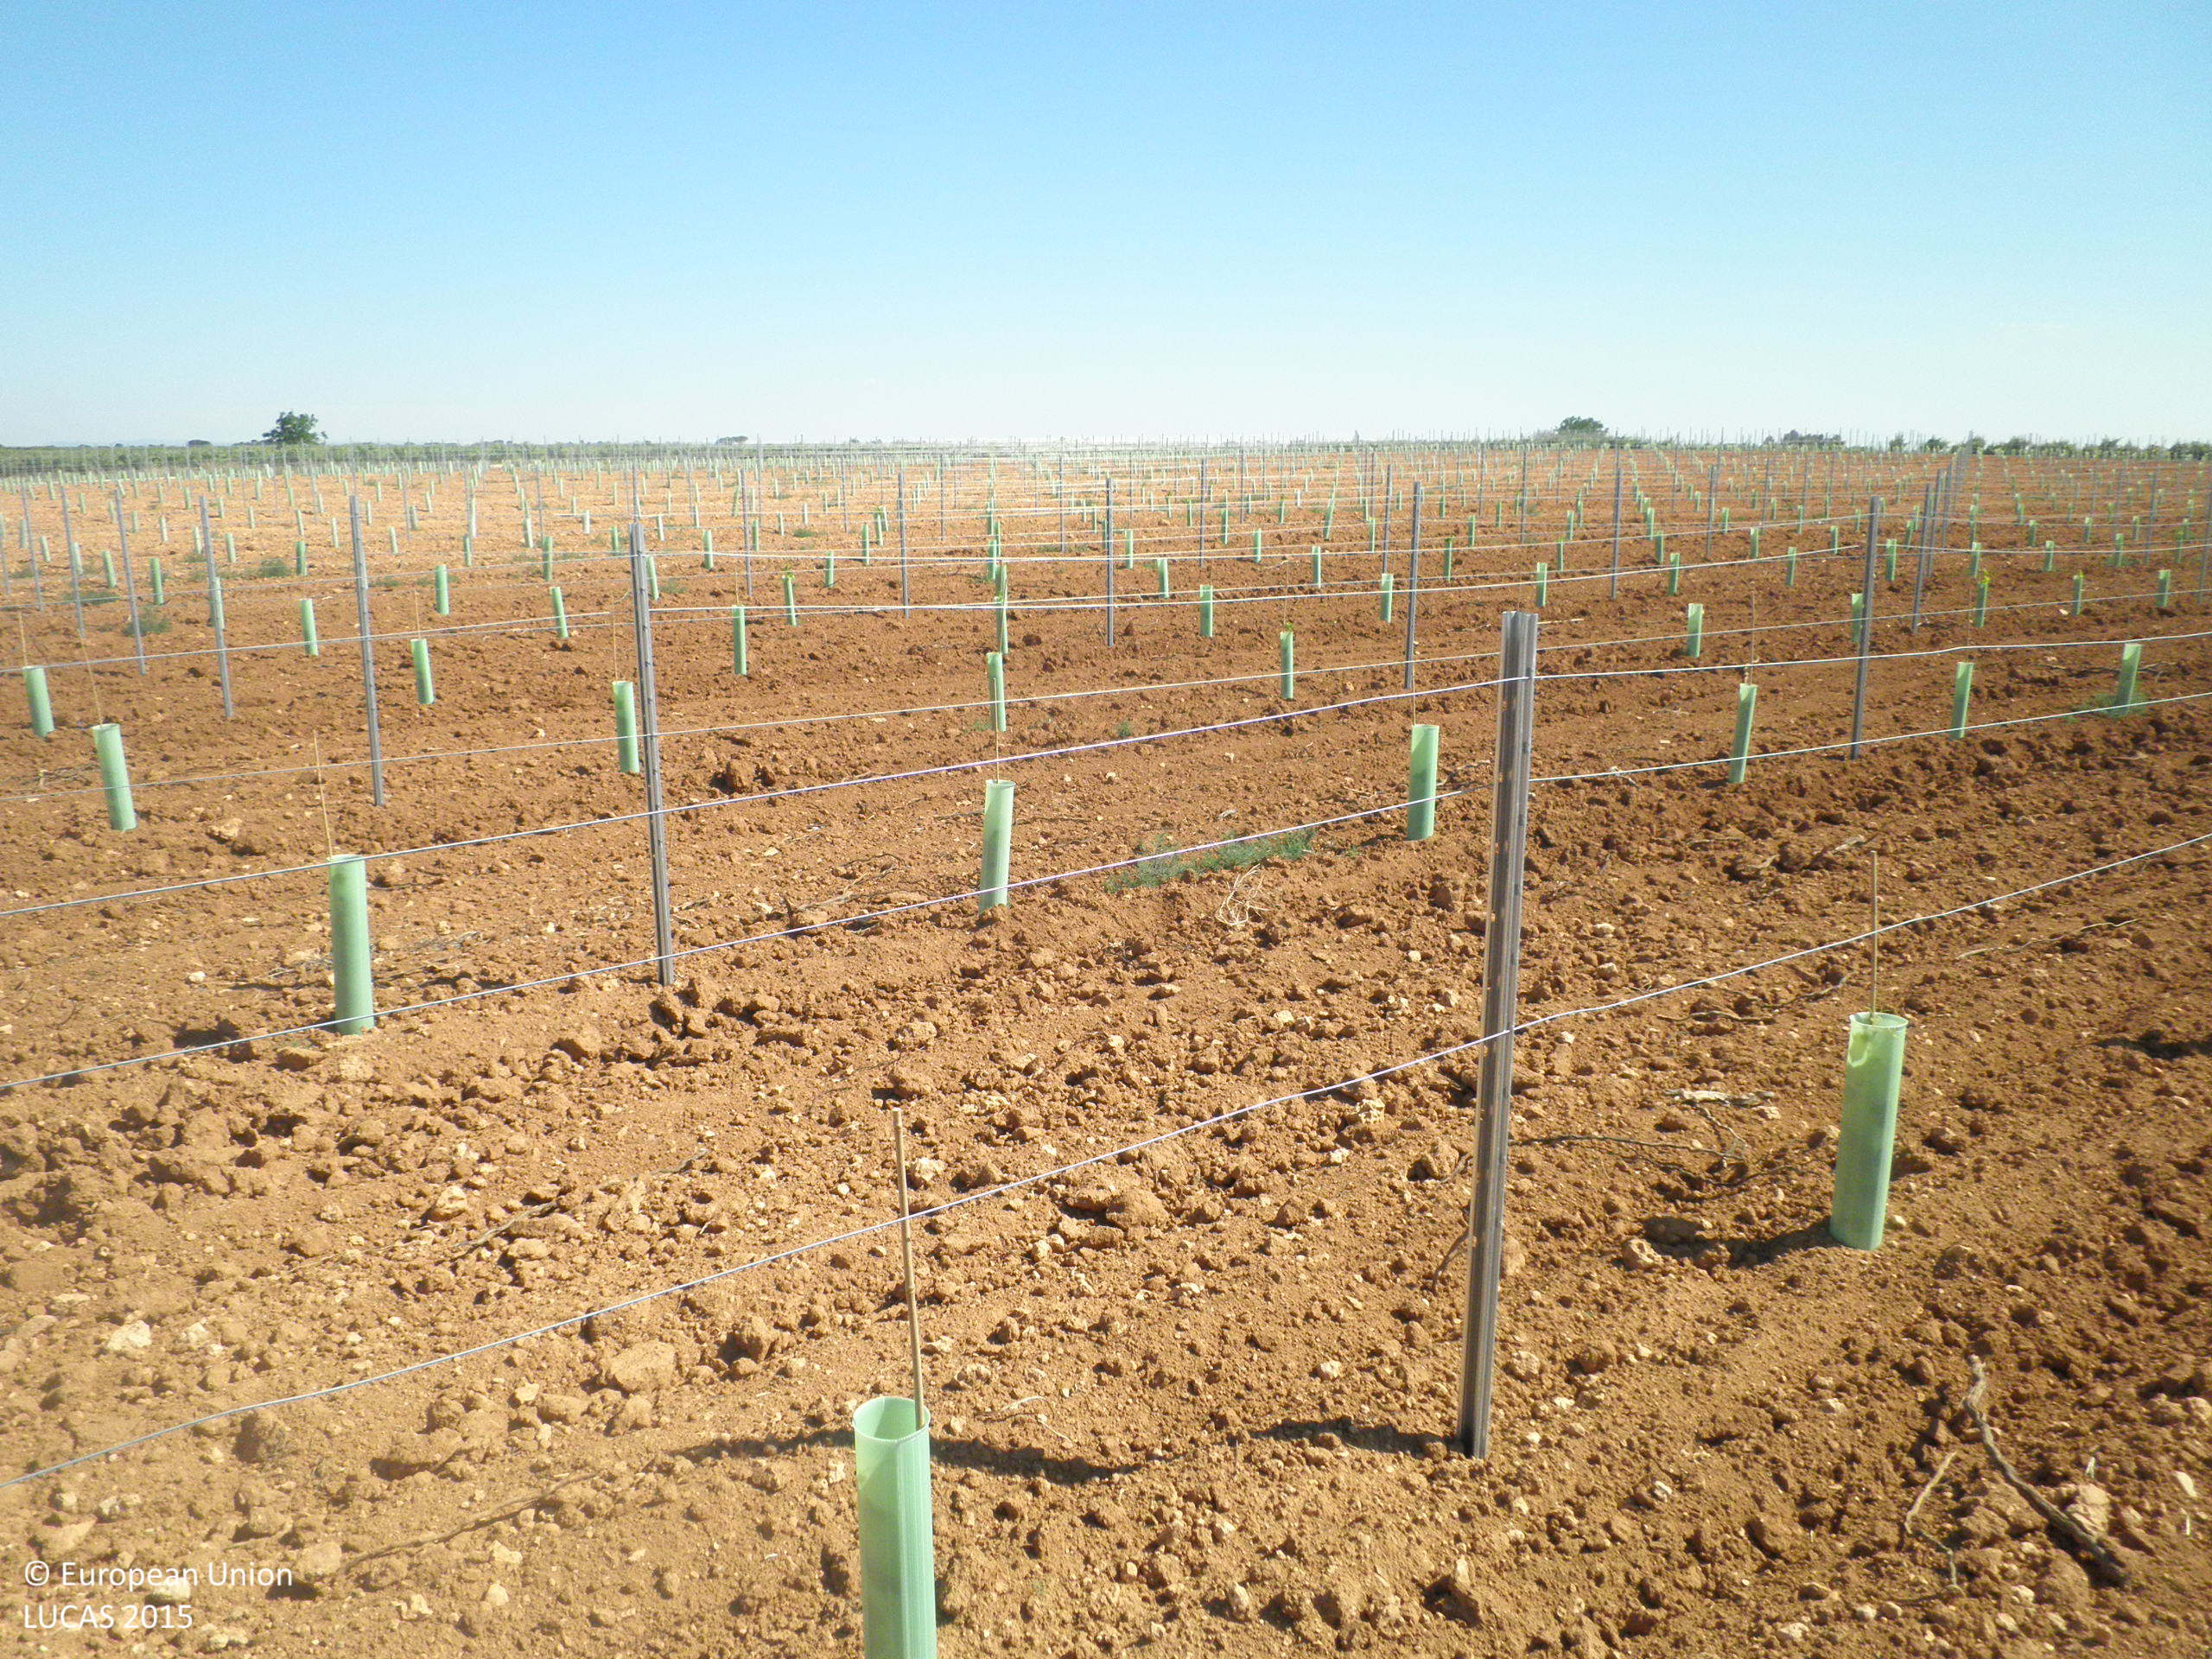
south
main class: Cropland
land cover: Vineyards
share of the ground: < 10 %
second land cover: Other bare soil
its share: > 75 %
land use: Agriculture (excluding fallow land and kitchen gardens)
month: June
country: ES
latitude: 39.4280
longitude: -1.7731
